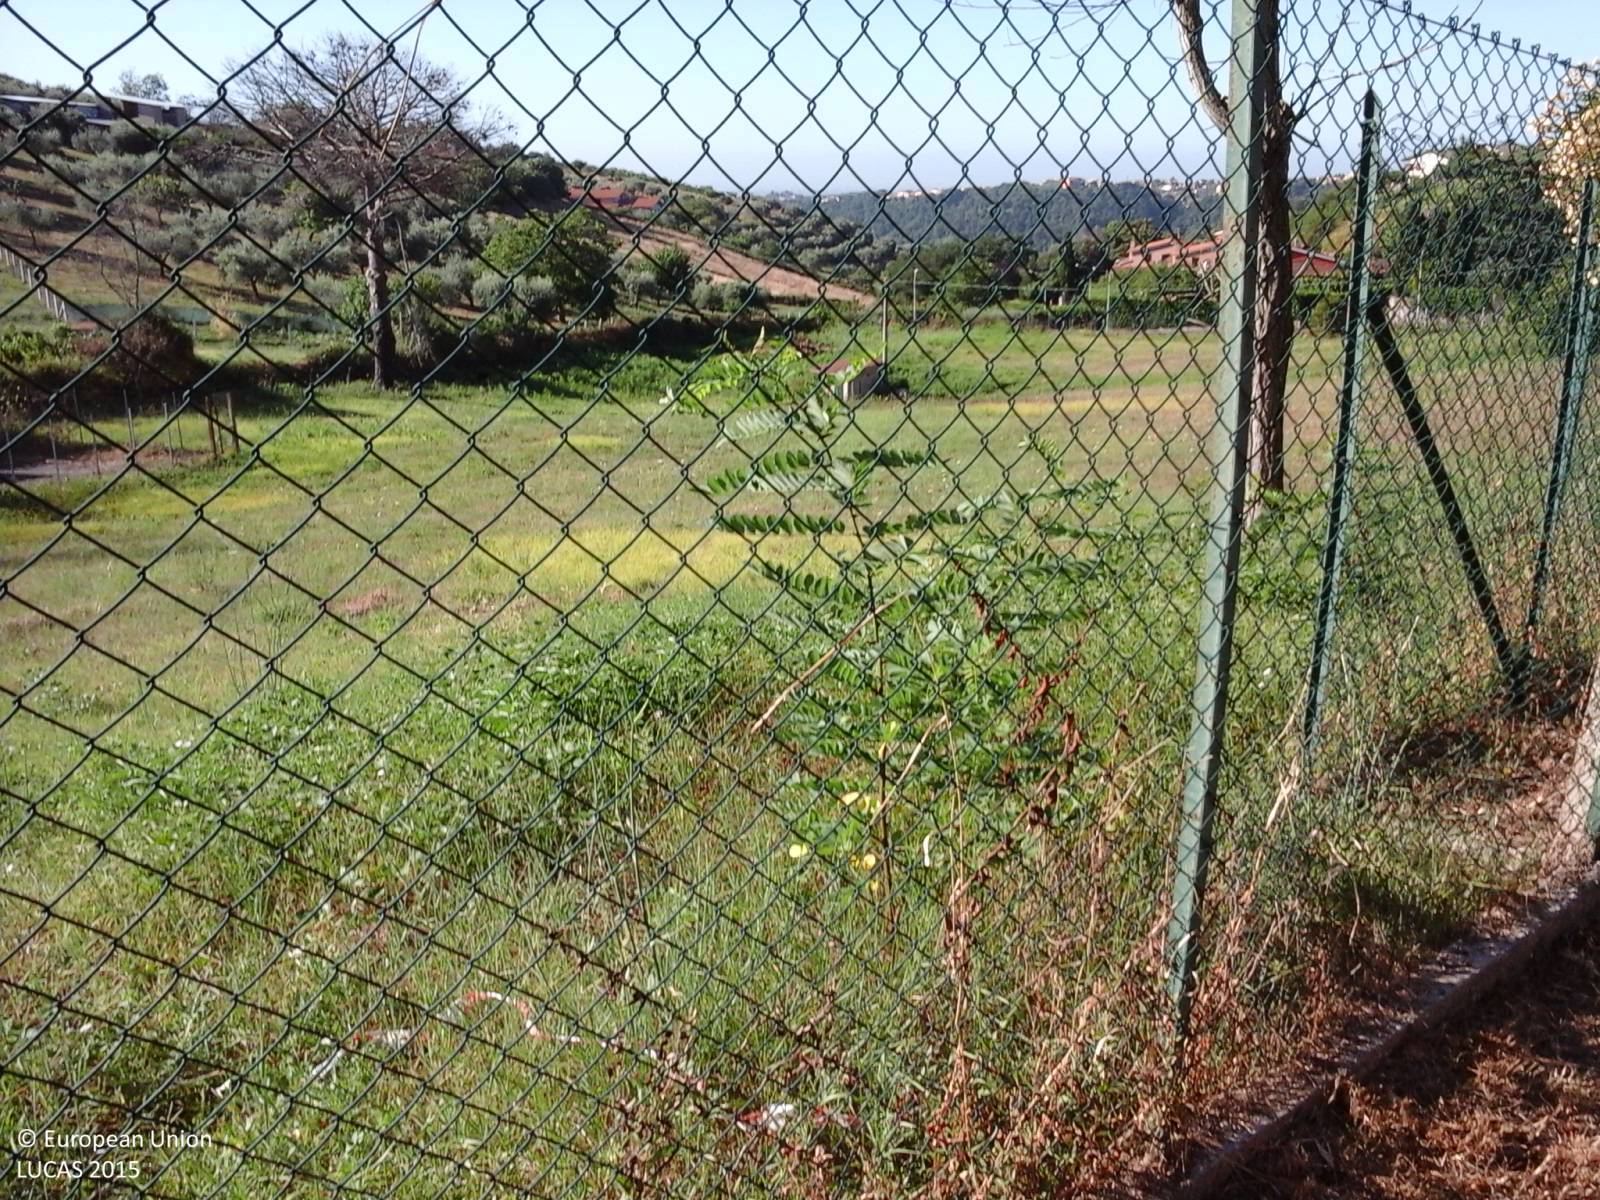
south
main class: Grassland
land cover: Grassland without tree/shrub cover
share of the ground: > 75 %
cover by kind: herbaceous plants 100 %
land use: Agriculture (excluding fallow land and kitchen gardens)
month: July
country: IT
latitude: 42.1167
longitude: 12.5188
